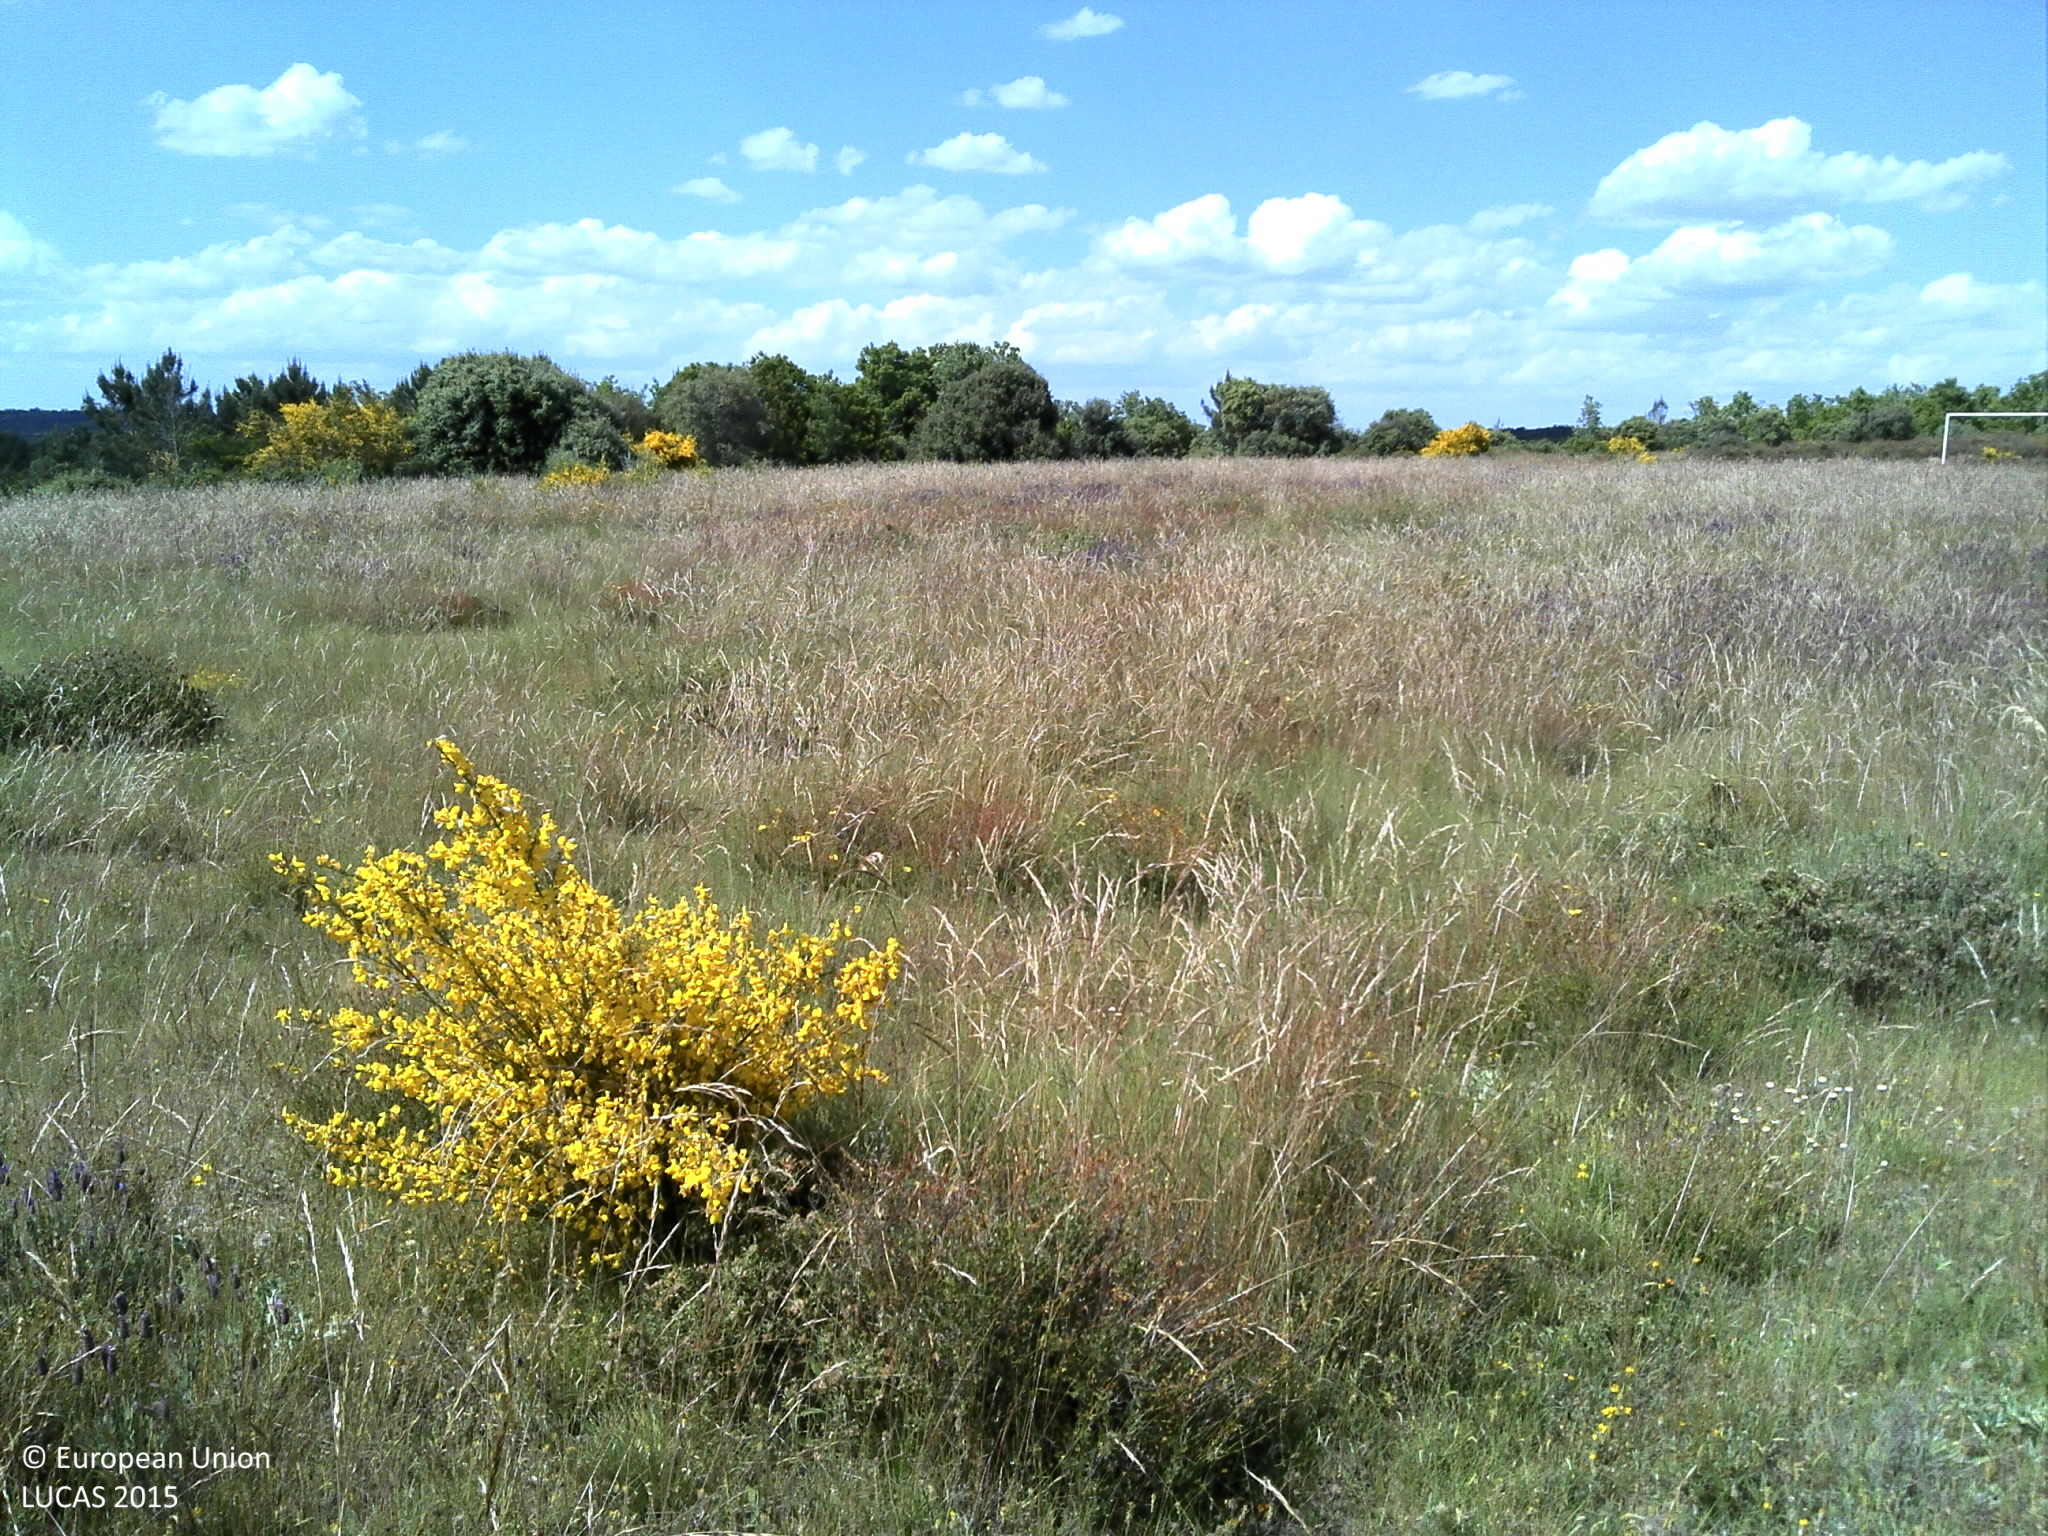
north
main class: Grassland
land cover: Grassland without tree/shrub cover
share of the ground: > 75 %
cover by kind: herbaceous plants 95 %, shrubs 5 %
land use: Abandoned areas
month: May
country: PT
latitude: 41.6230
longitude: -6.2662
